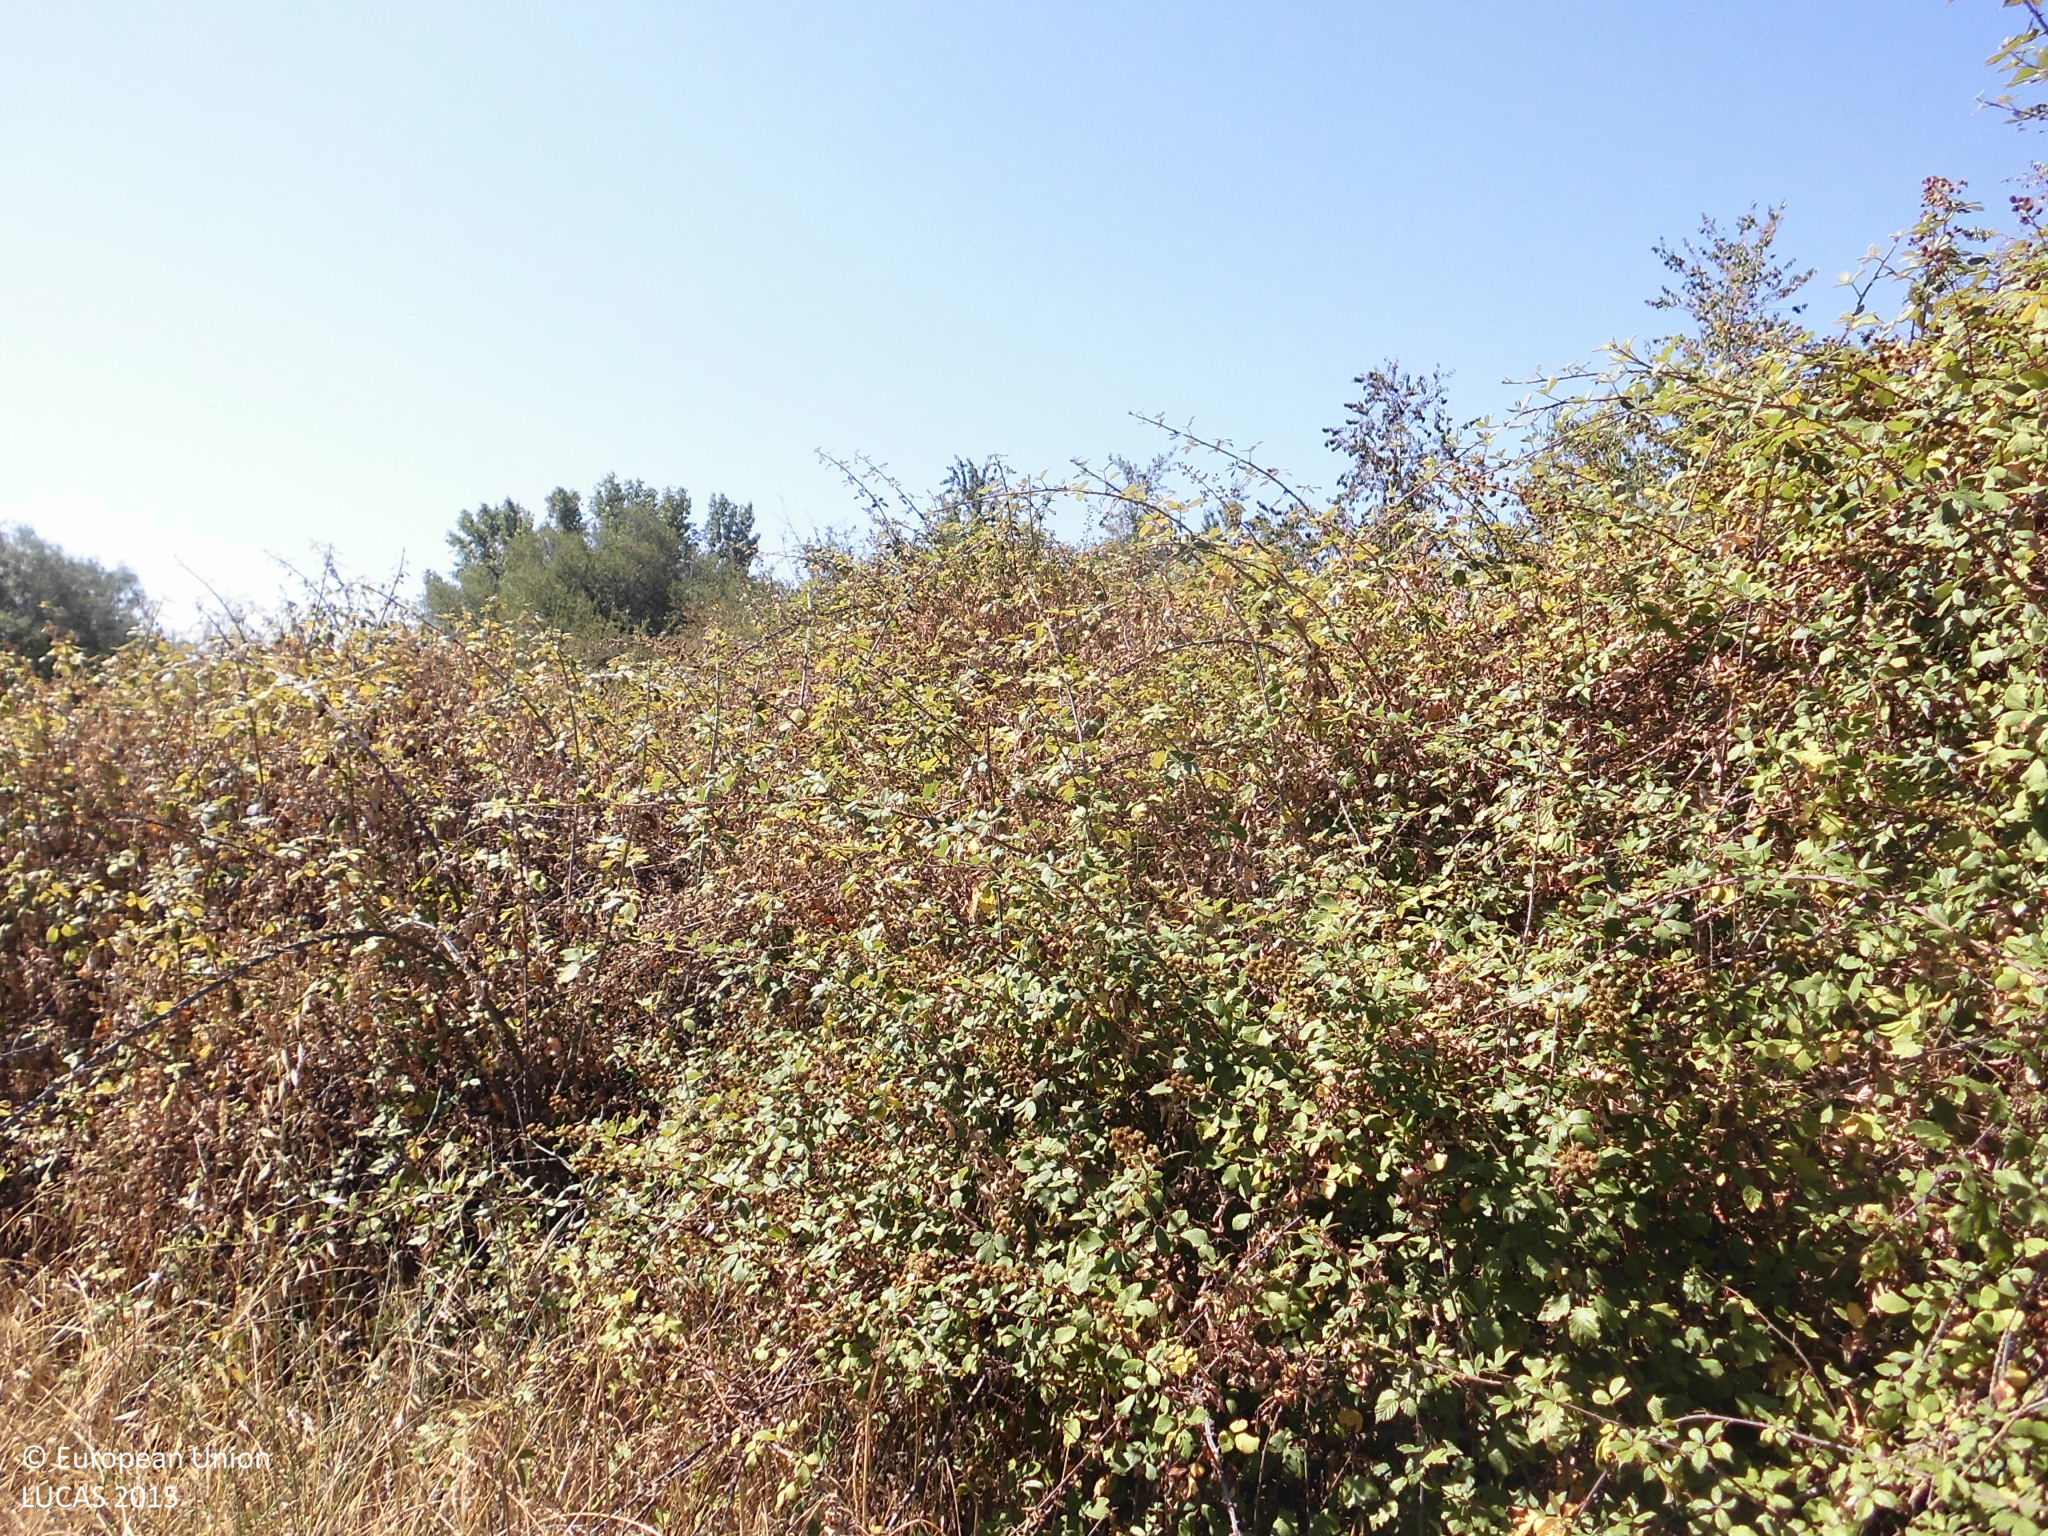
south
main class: Shrubland
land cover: Shrubland with sparse tree cover
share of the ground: > 75 %
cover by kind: herbaceous plants 65 %, shrubs 30 %, broadleaved forest trees 5 %
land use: Semi-natural and natural areas not in use
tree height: > 5 m
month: July
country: ES
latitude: 40.0826
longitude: -6.1279
